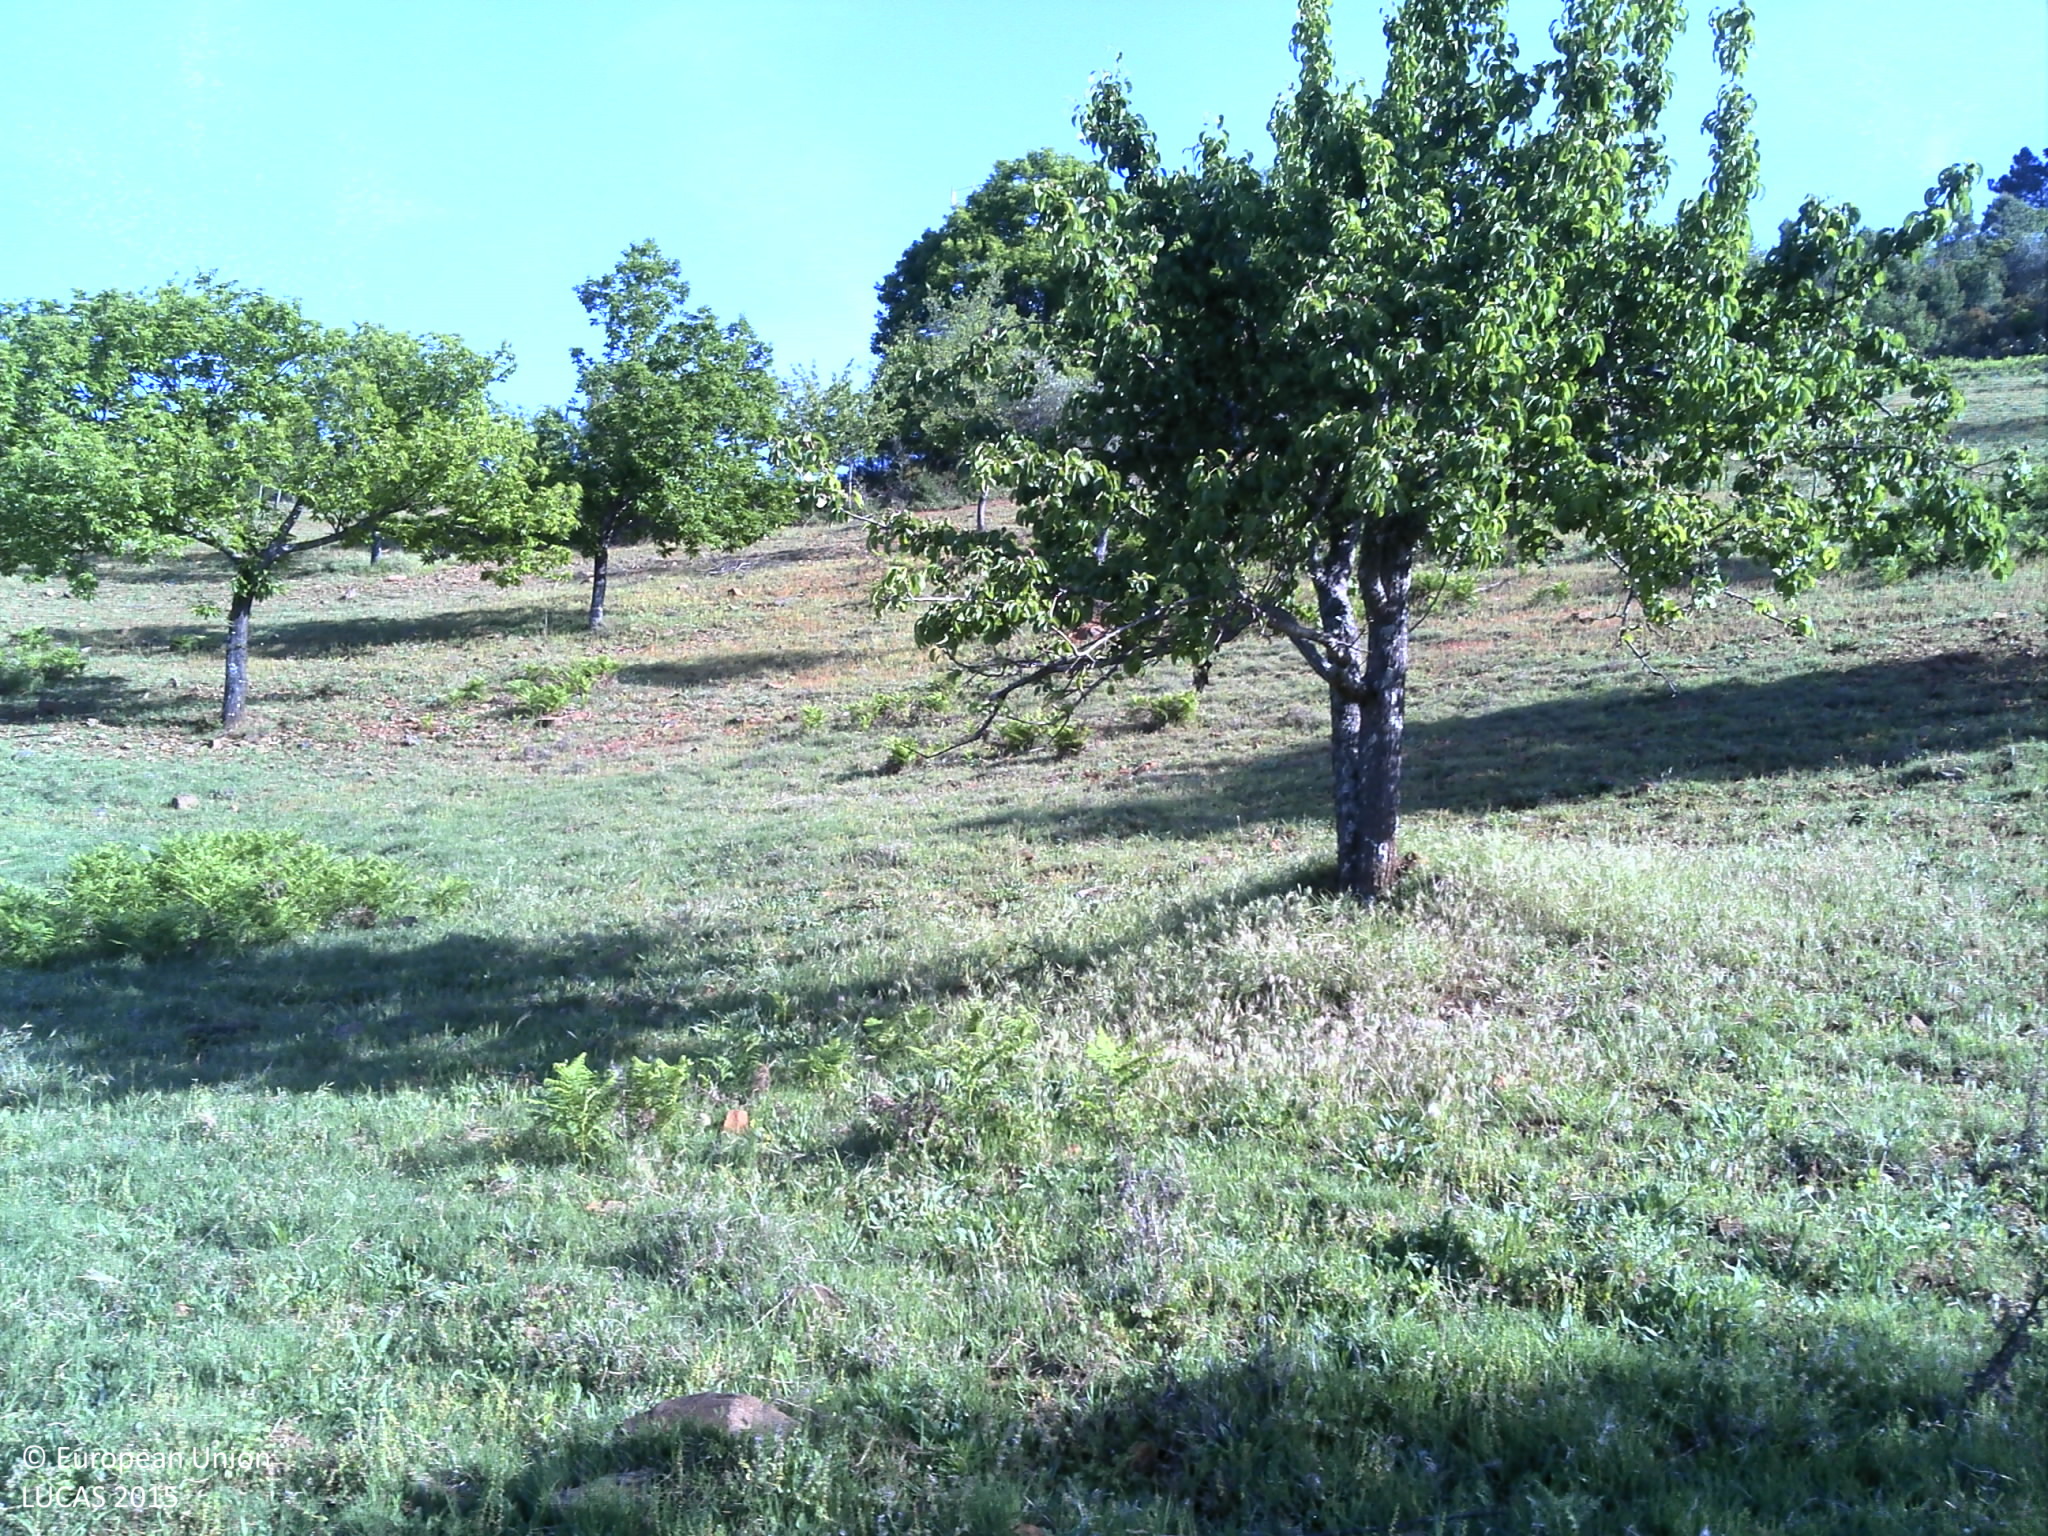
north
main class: Cropland
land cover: Olive groves
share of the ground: 10 - 25 %
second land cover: Grassland without tree/shrub cover
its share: 50 - 75 %
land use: Agriculture (excluding fallow land and kitchen gardens)
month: May
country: PT
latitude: 41.8325
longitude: -6.9890
